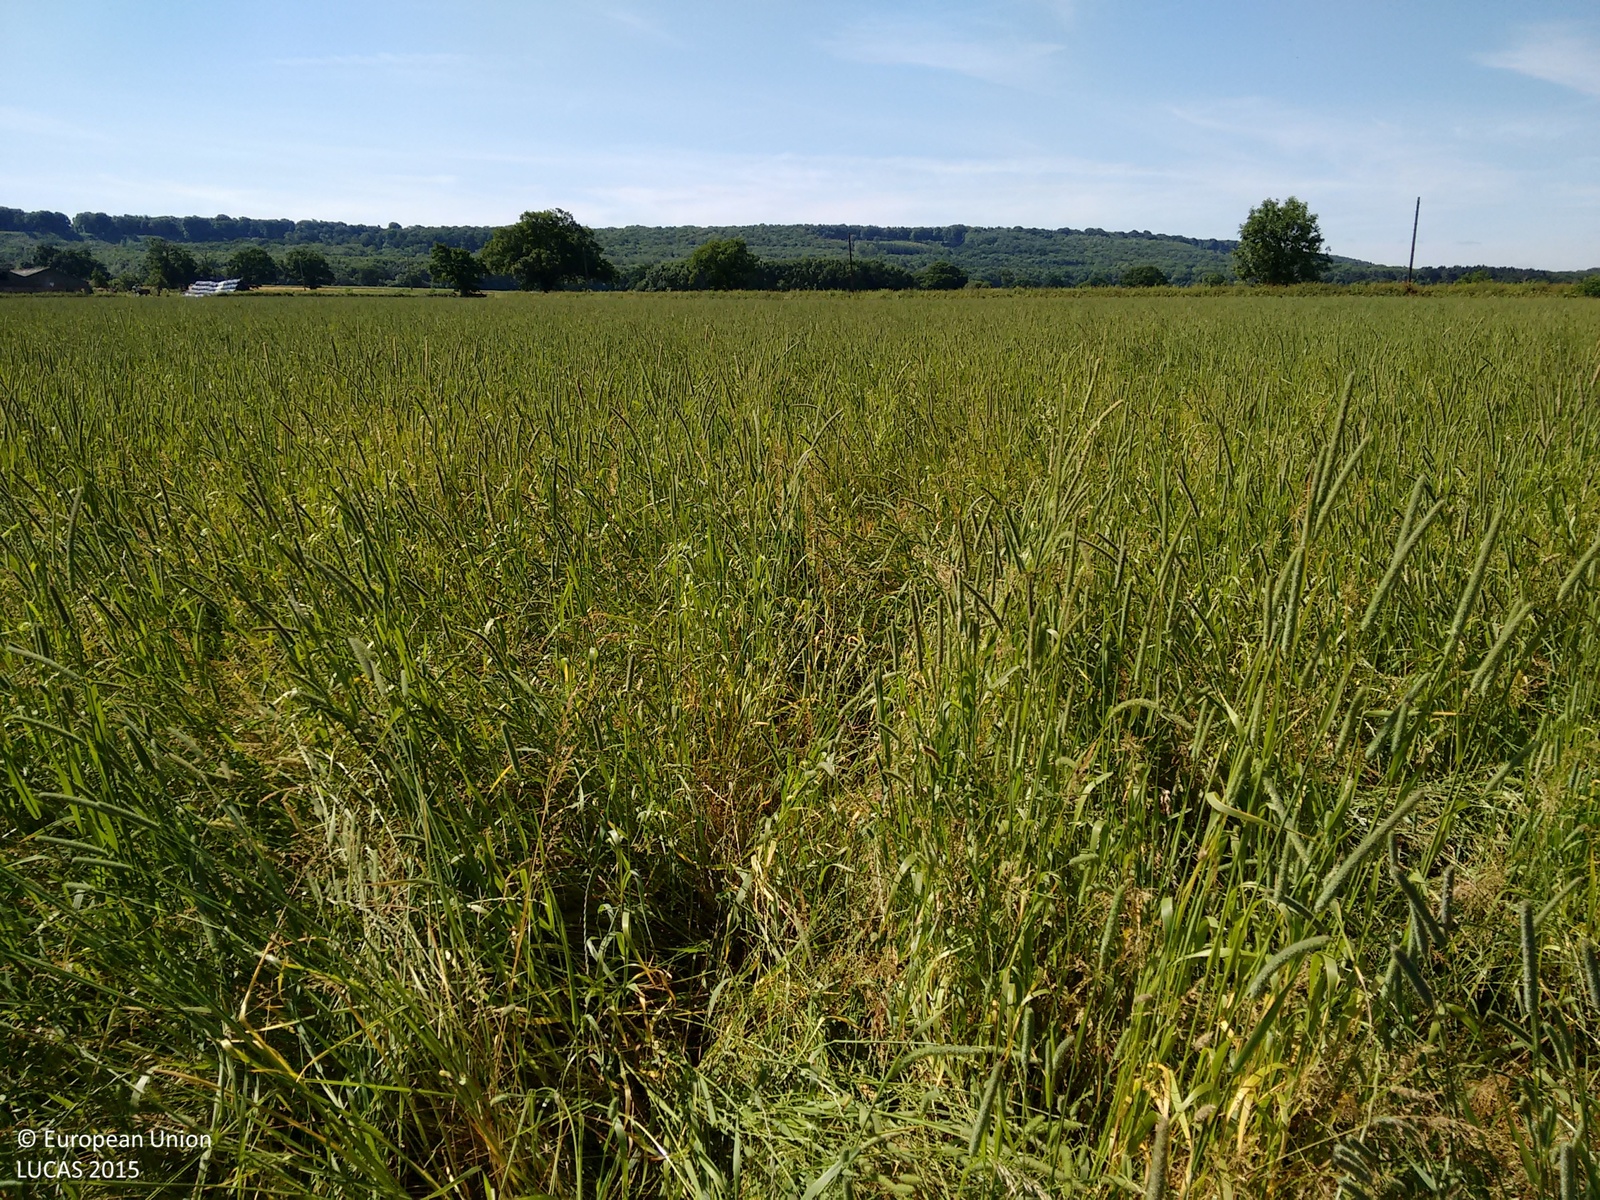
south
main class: Cropland
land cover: Common wheat
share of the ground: > 75 %
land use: Agriculture (excluding fallow land and kitchen gardens)
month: July
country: GB
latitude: 52.8975
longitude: -0.8191
